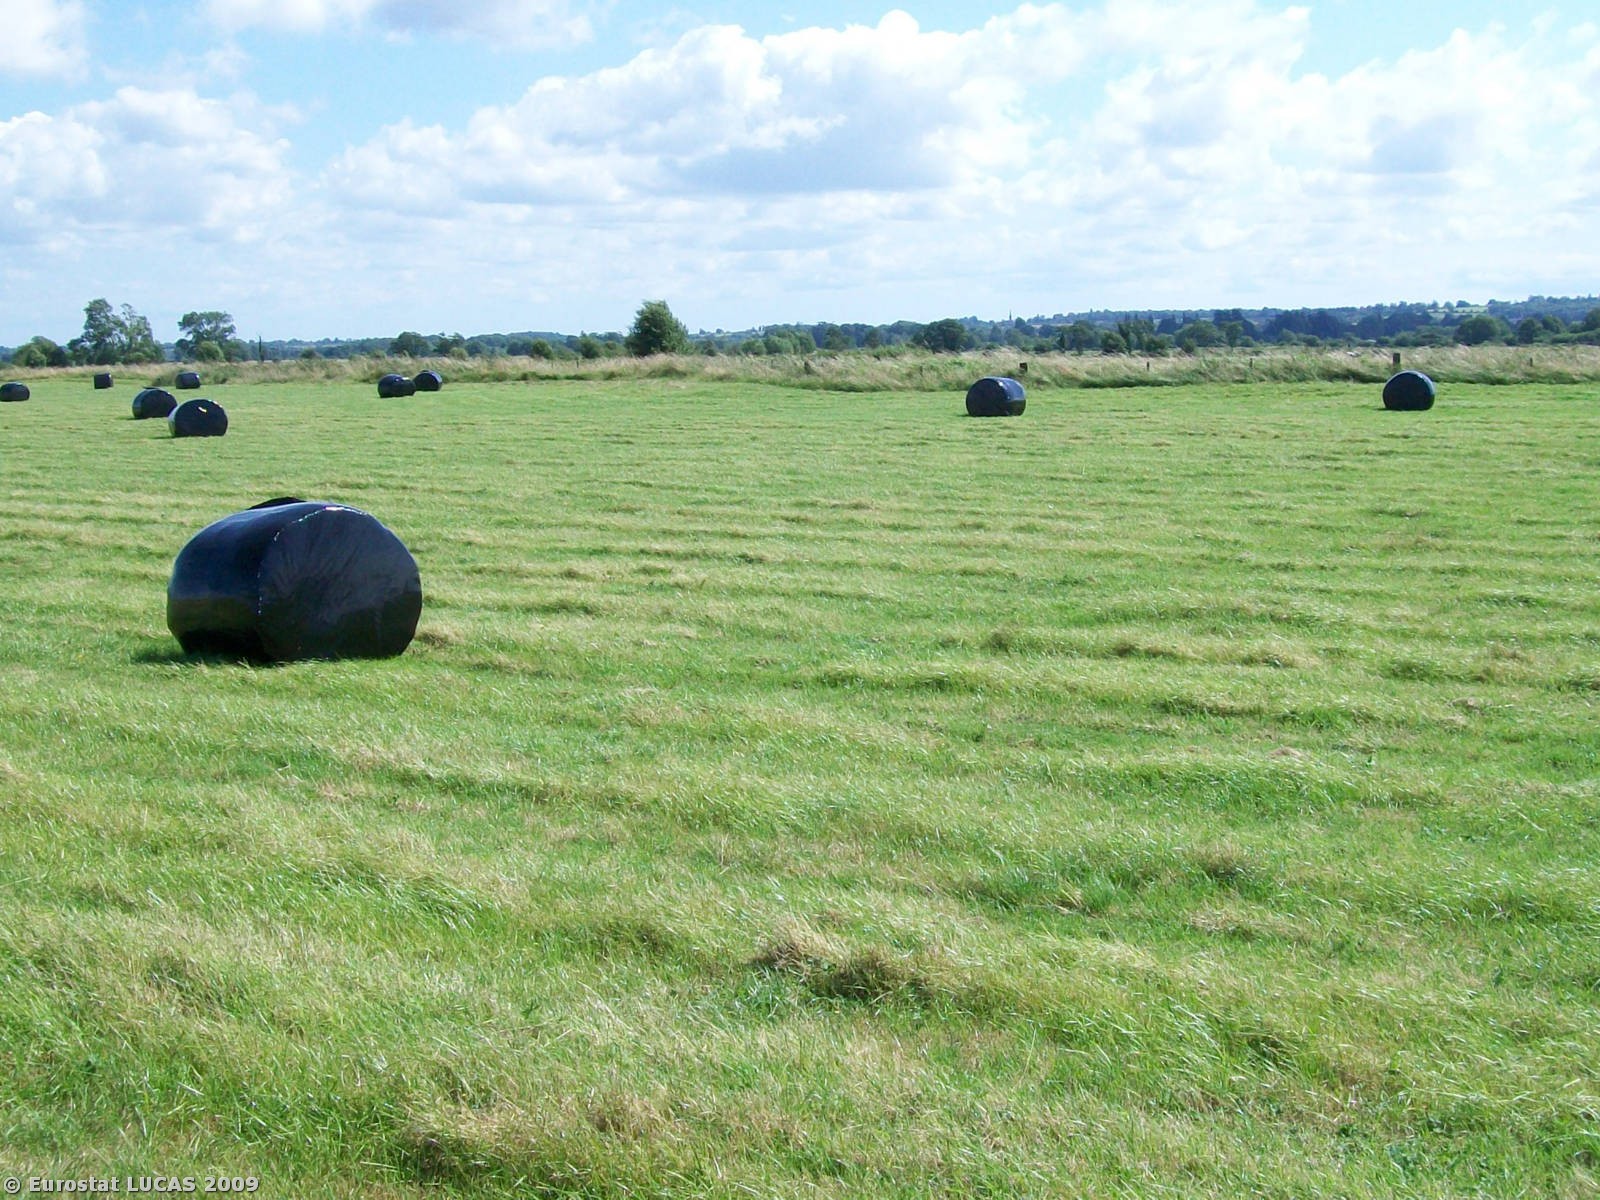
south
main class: Grassland
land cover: Grassland without tree/shrub cover
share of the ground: > 75 %
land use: Agriculture (excluding fallow land and kitchen gardens)
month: July
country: GB
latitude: 51.1288
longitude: -2.6870
